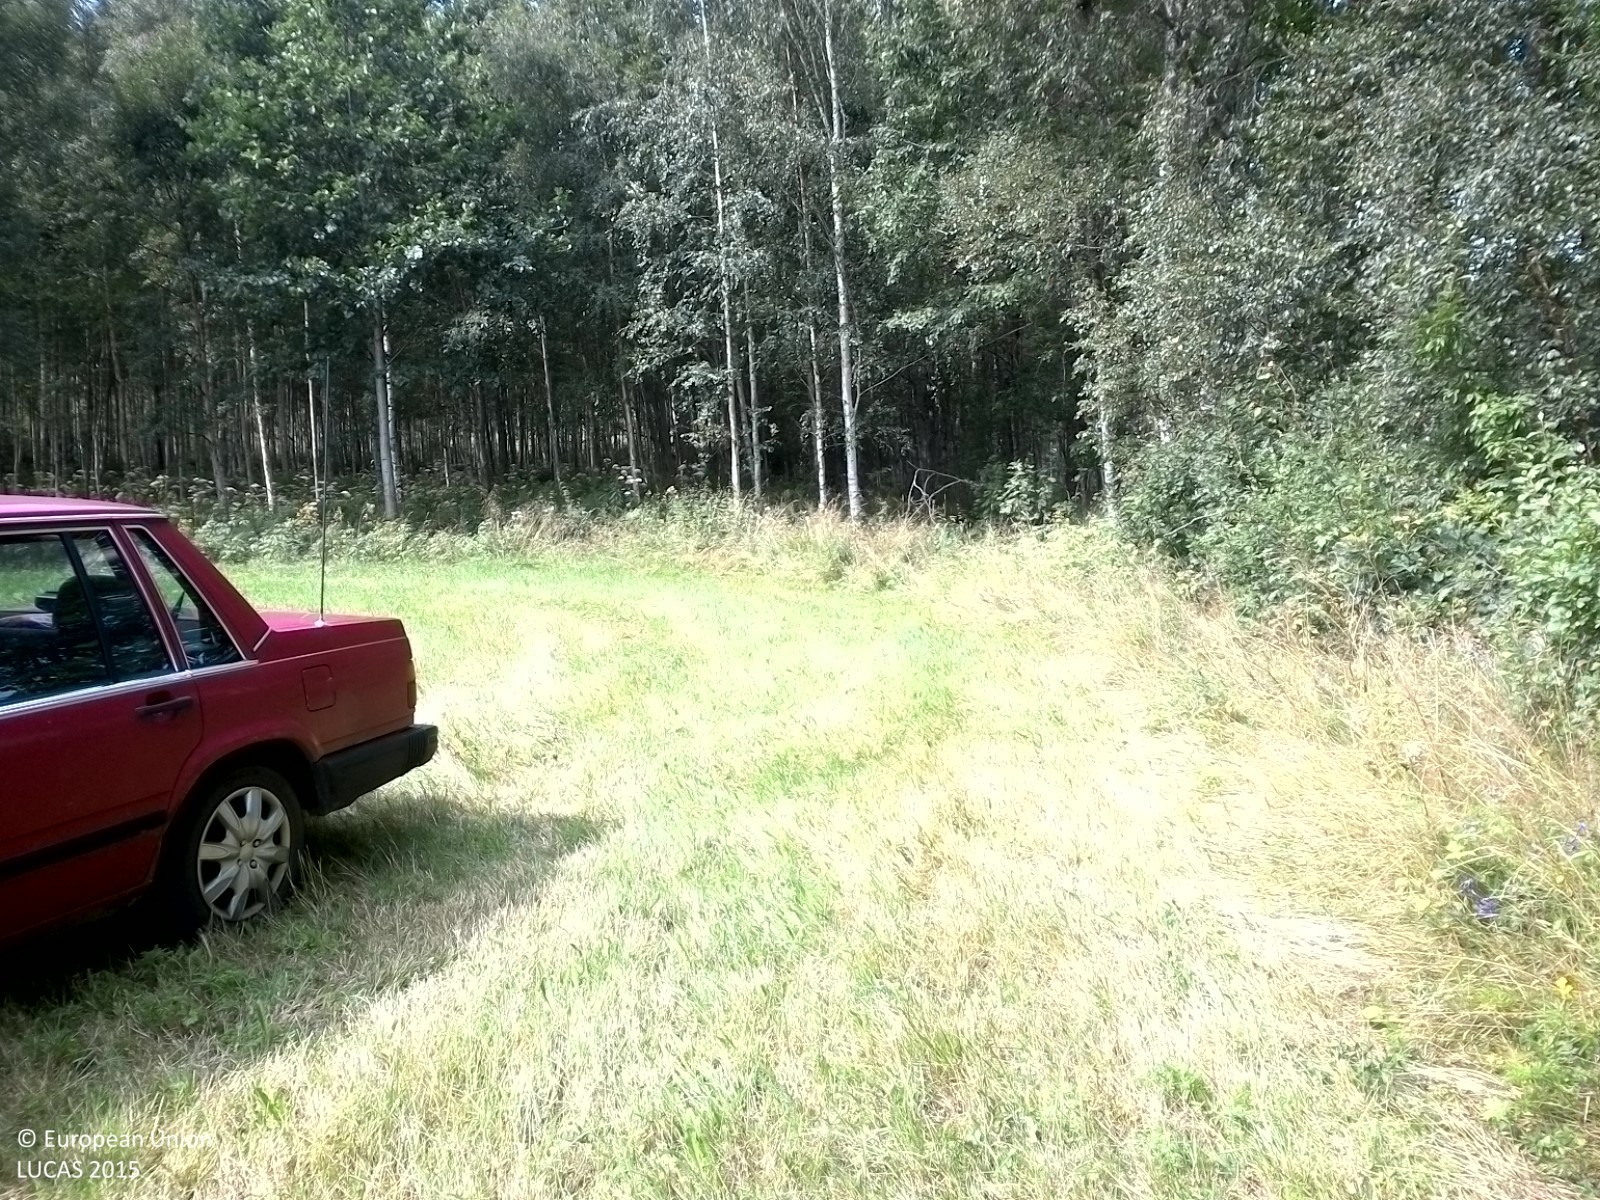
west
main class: Cropland
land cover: Temporary grasslands
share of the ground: > 75 %
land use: Agriculture (excluding fallow land and kitchen gardens)
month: August
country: SE
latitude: 59.0703
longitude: 14.8238
